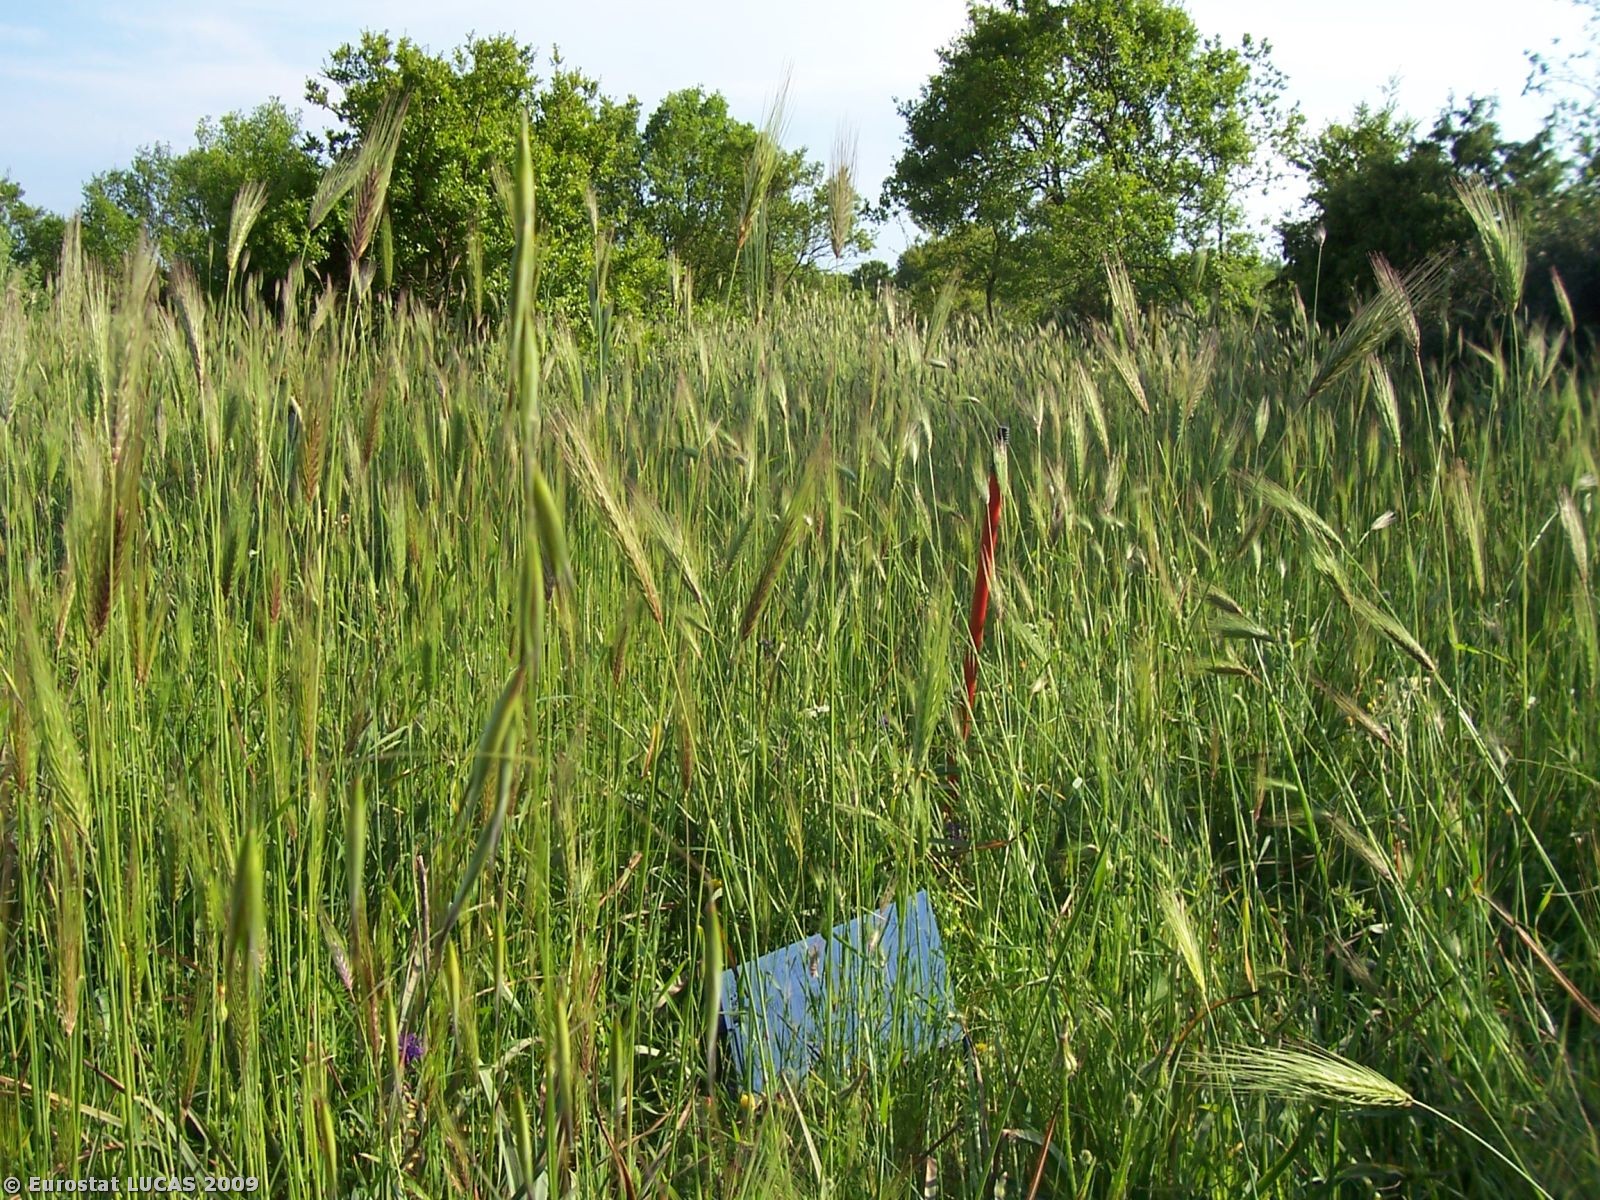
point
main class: Grassland
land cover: Grassland with sparse tree/shrub cover
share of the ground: > 75 %
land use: Agriculture (excluding fallow land and kitchen gardens)
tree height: > 5 m
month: May
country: IT
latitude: 40.6271
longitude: 16.8452
